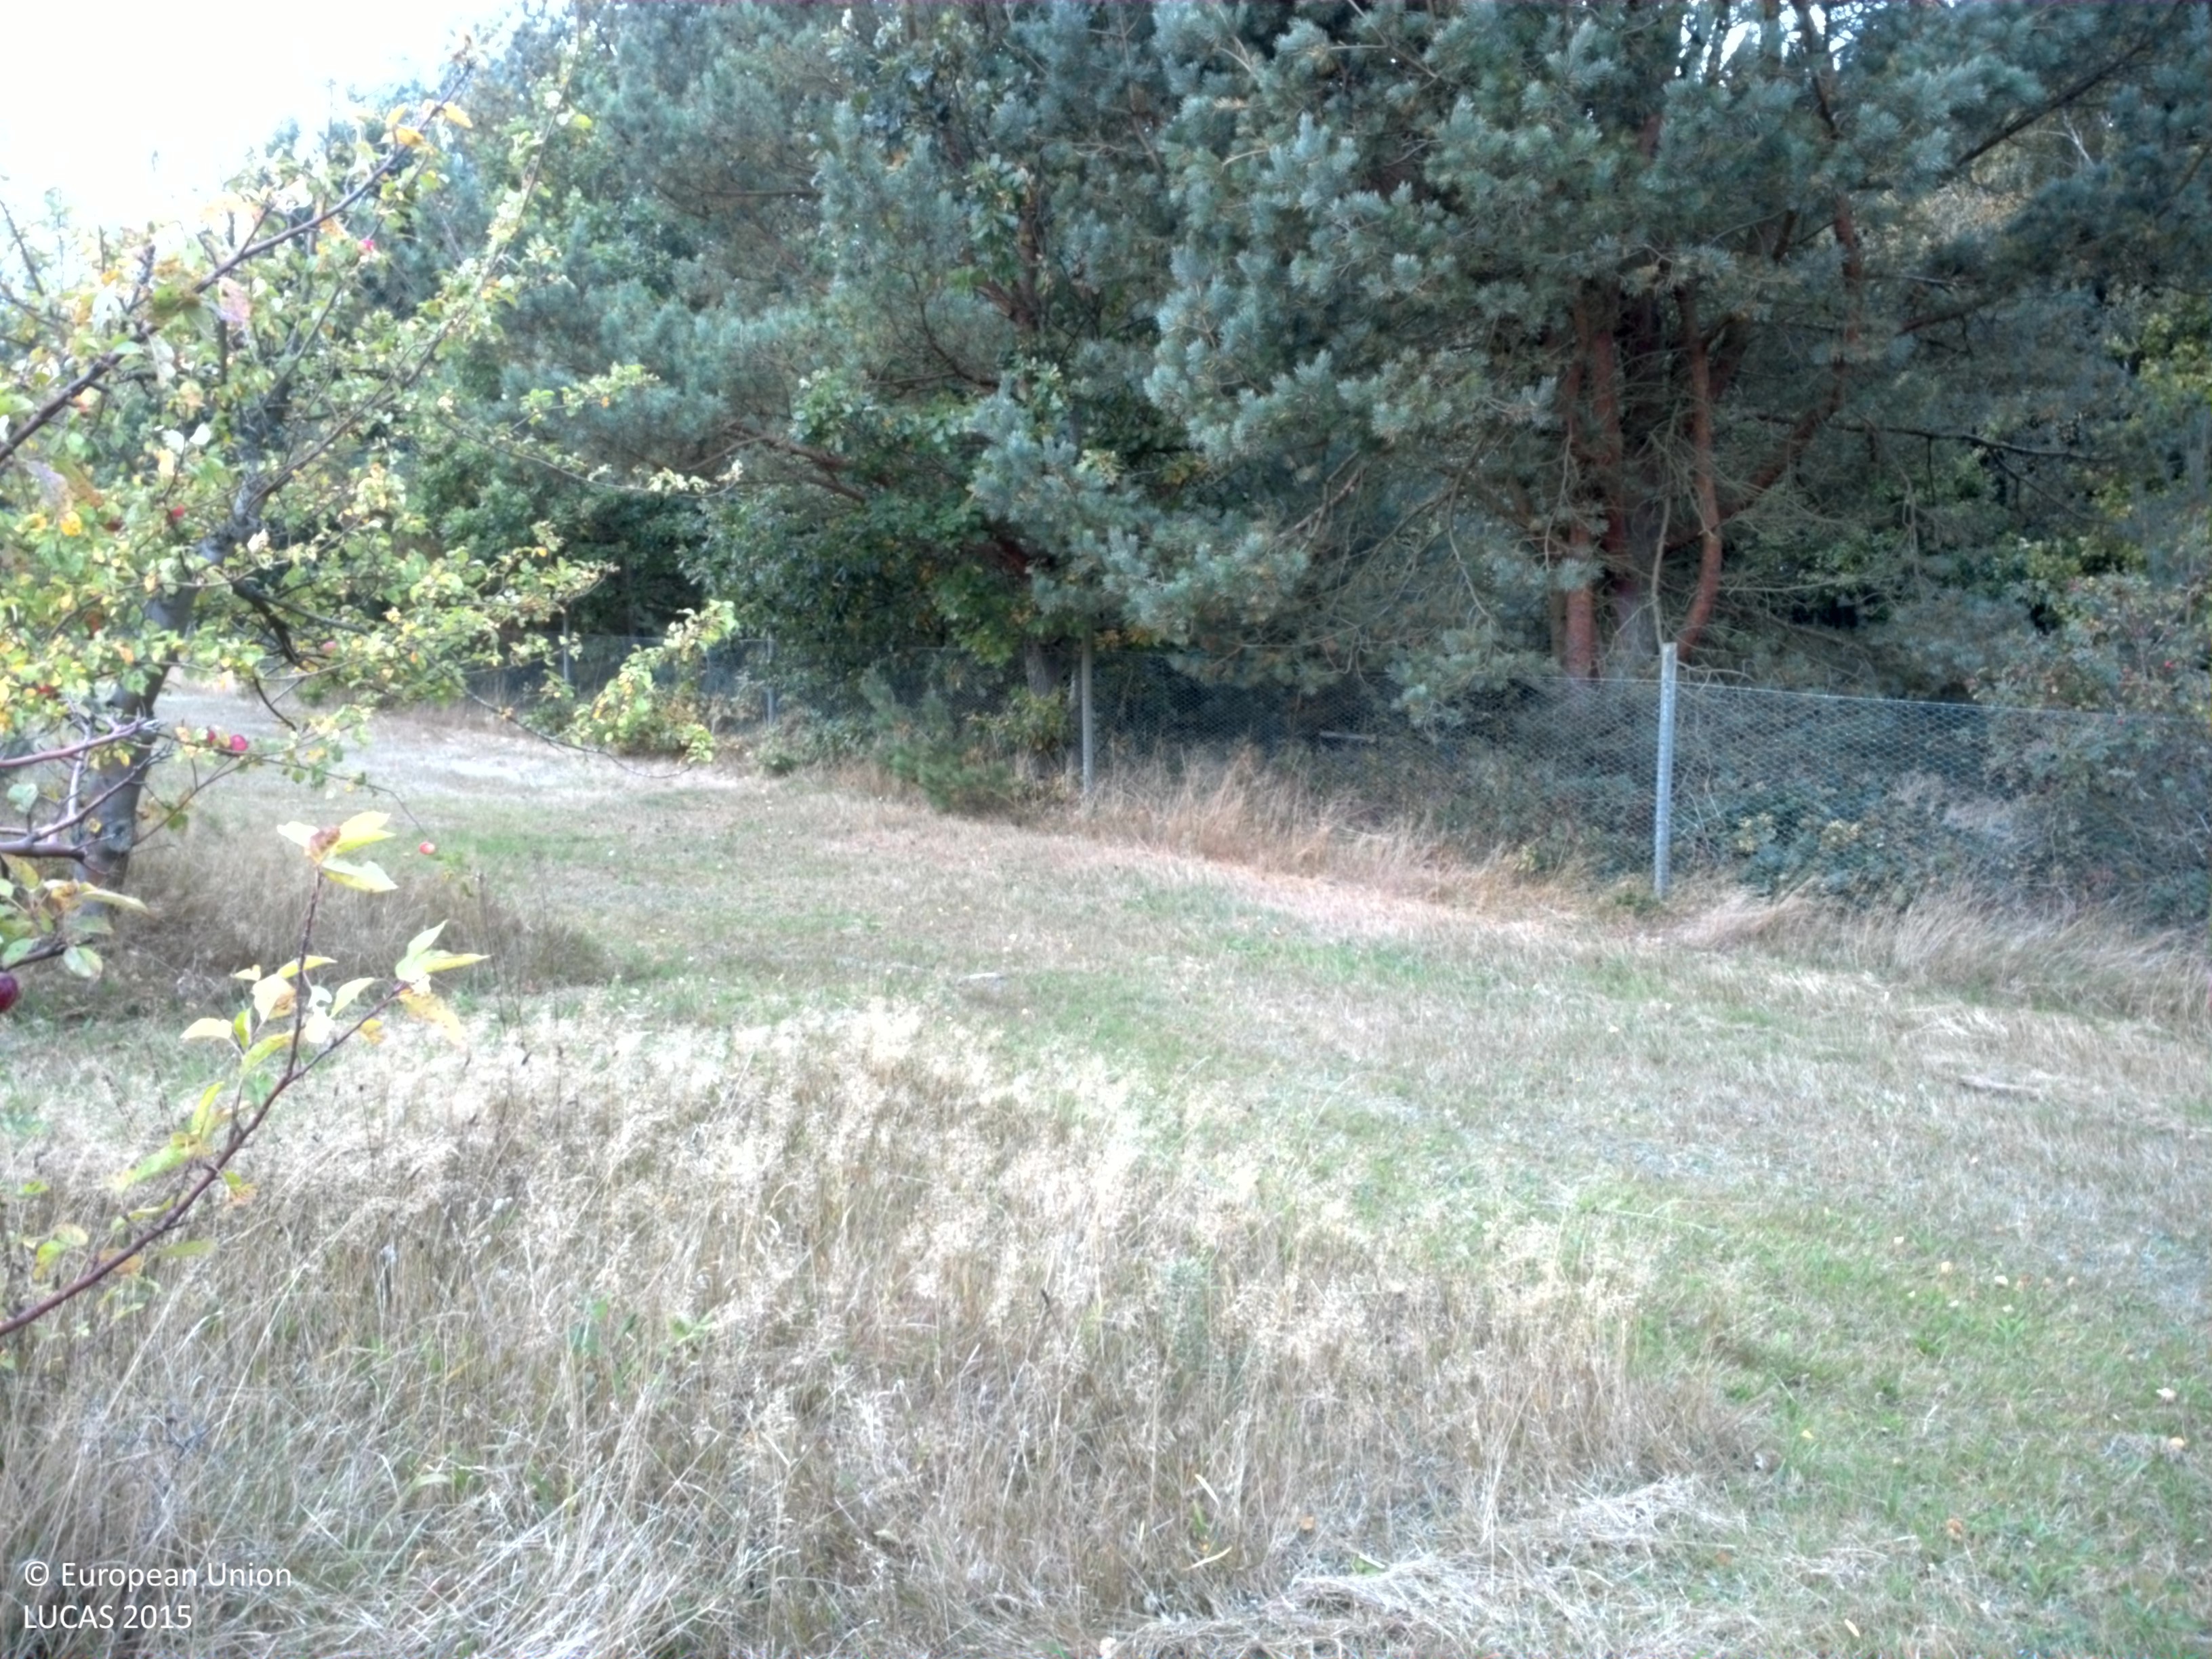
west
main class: Cropland
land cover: Apple fruit
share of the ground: 25 - 50 %
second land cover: Grassland without tree/shrub cover
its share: 50 - 75 %
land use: Agriculture (excluding fallow land and kitchen gardens)
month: October
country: SE
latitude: 55.5937
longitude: 14.2990
